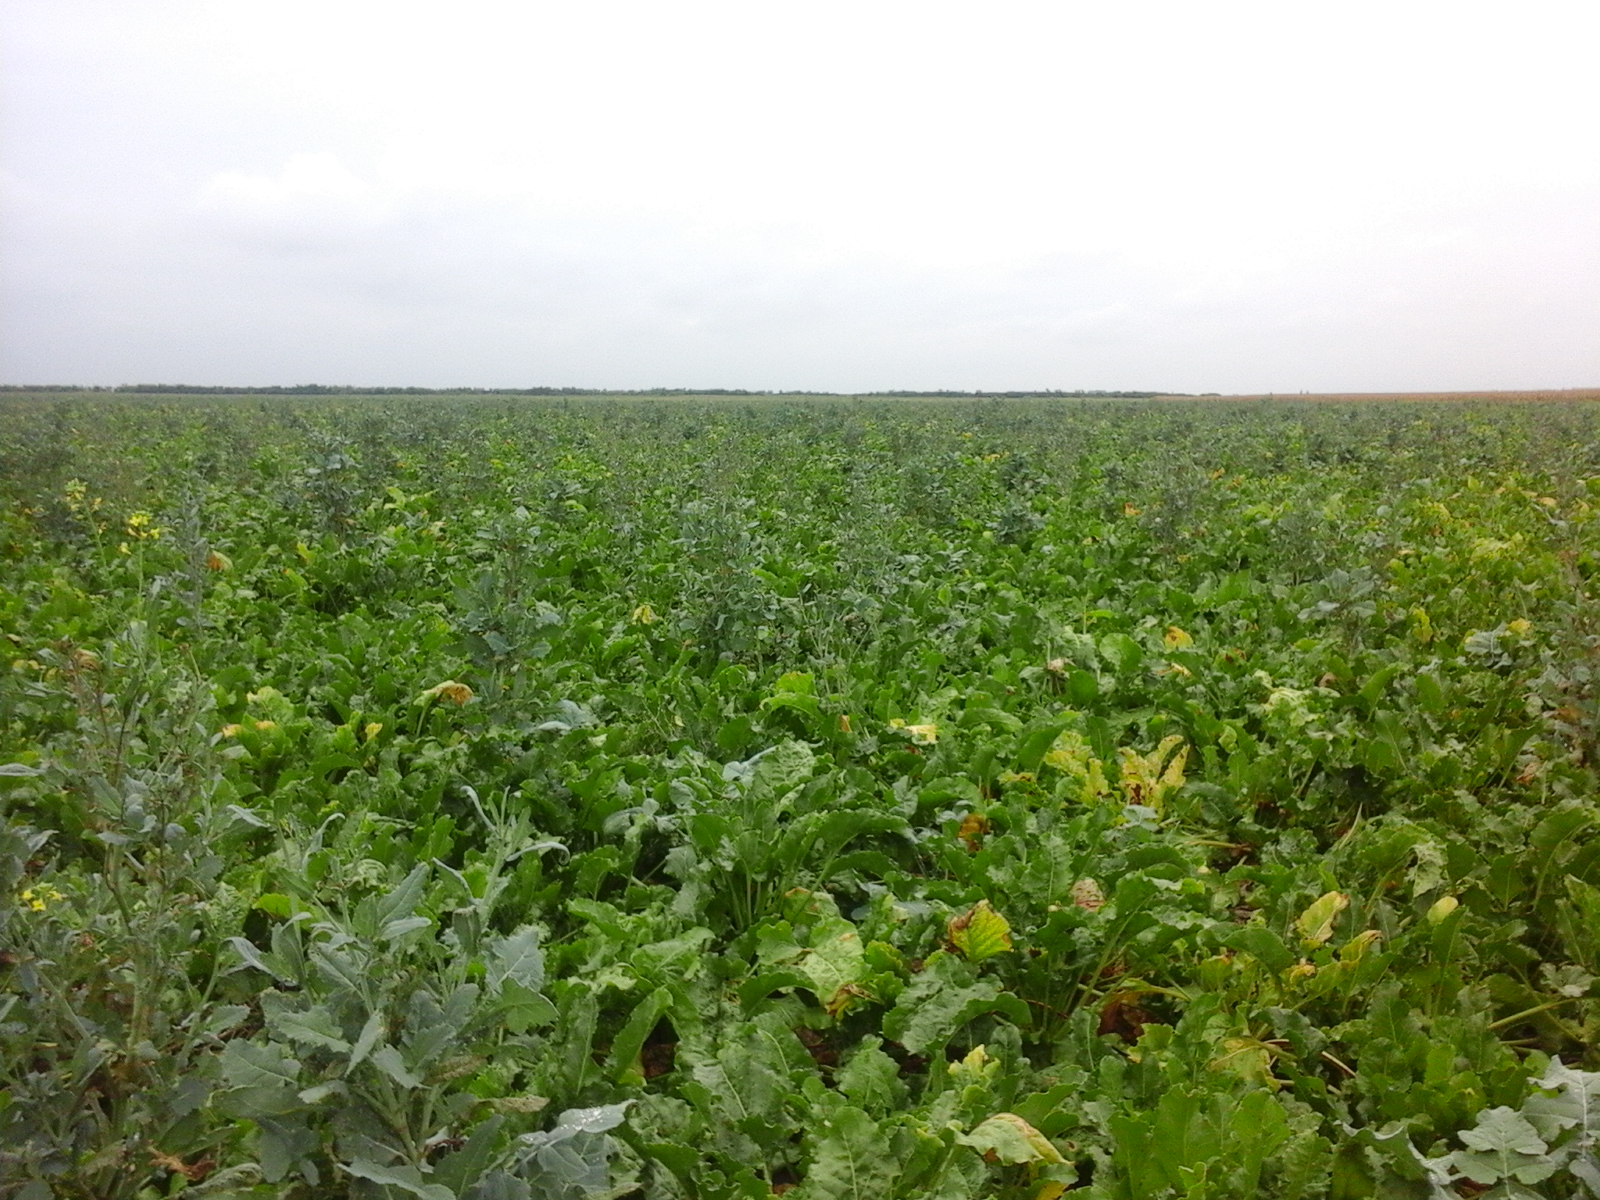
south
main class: Cropland
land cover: Sugar beet
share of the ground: > 75 %
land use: Agriculture (excluding fallow land and kitchen gardens)
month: September
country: RO
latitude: 47.1959
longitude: 21.8863
